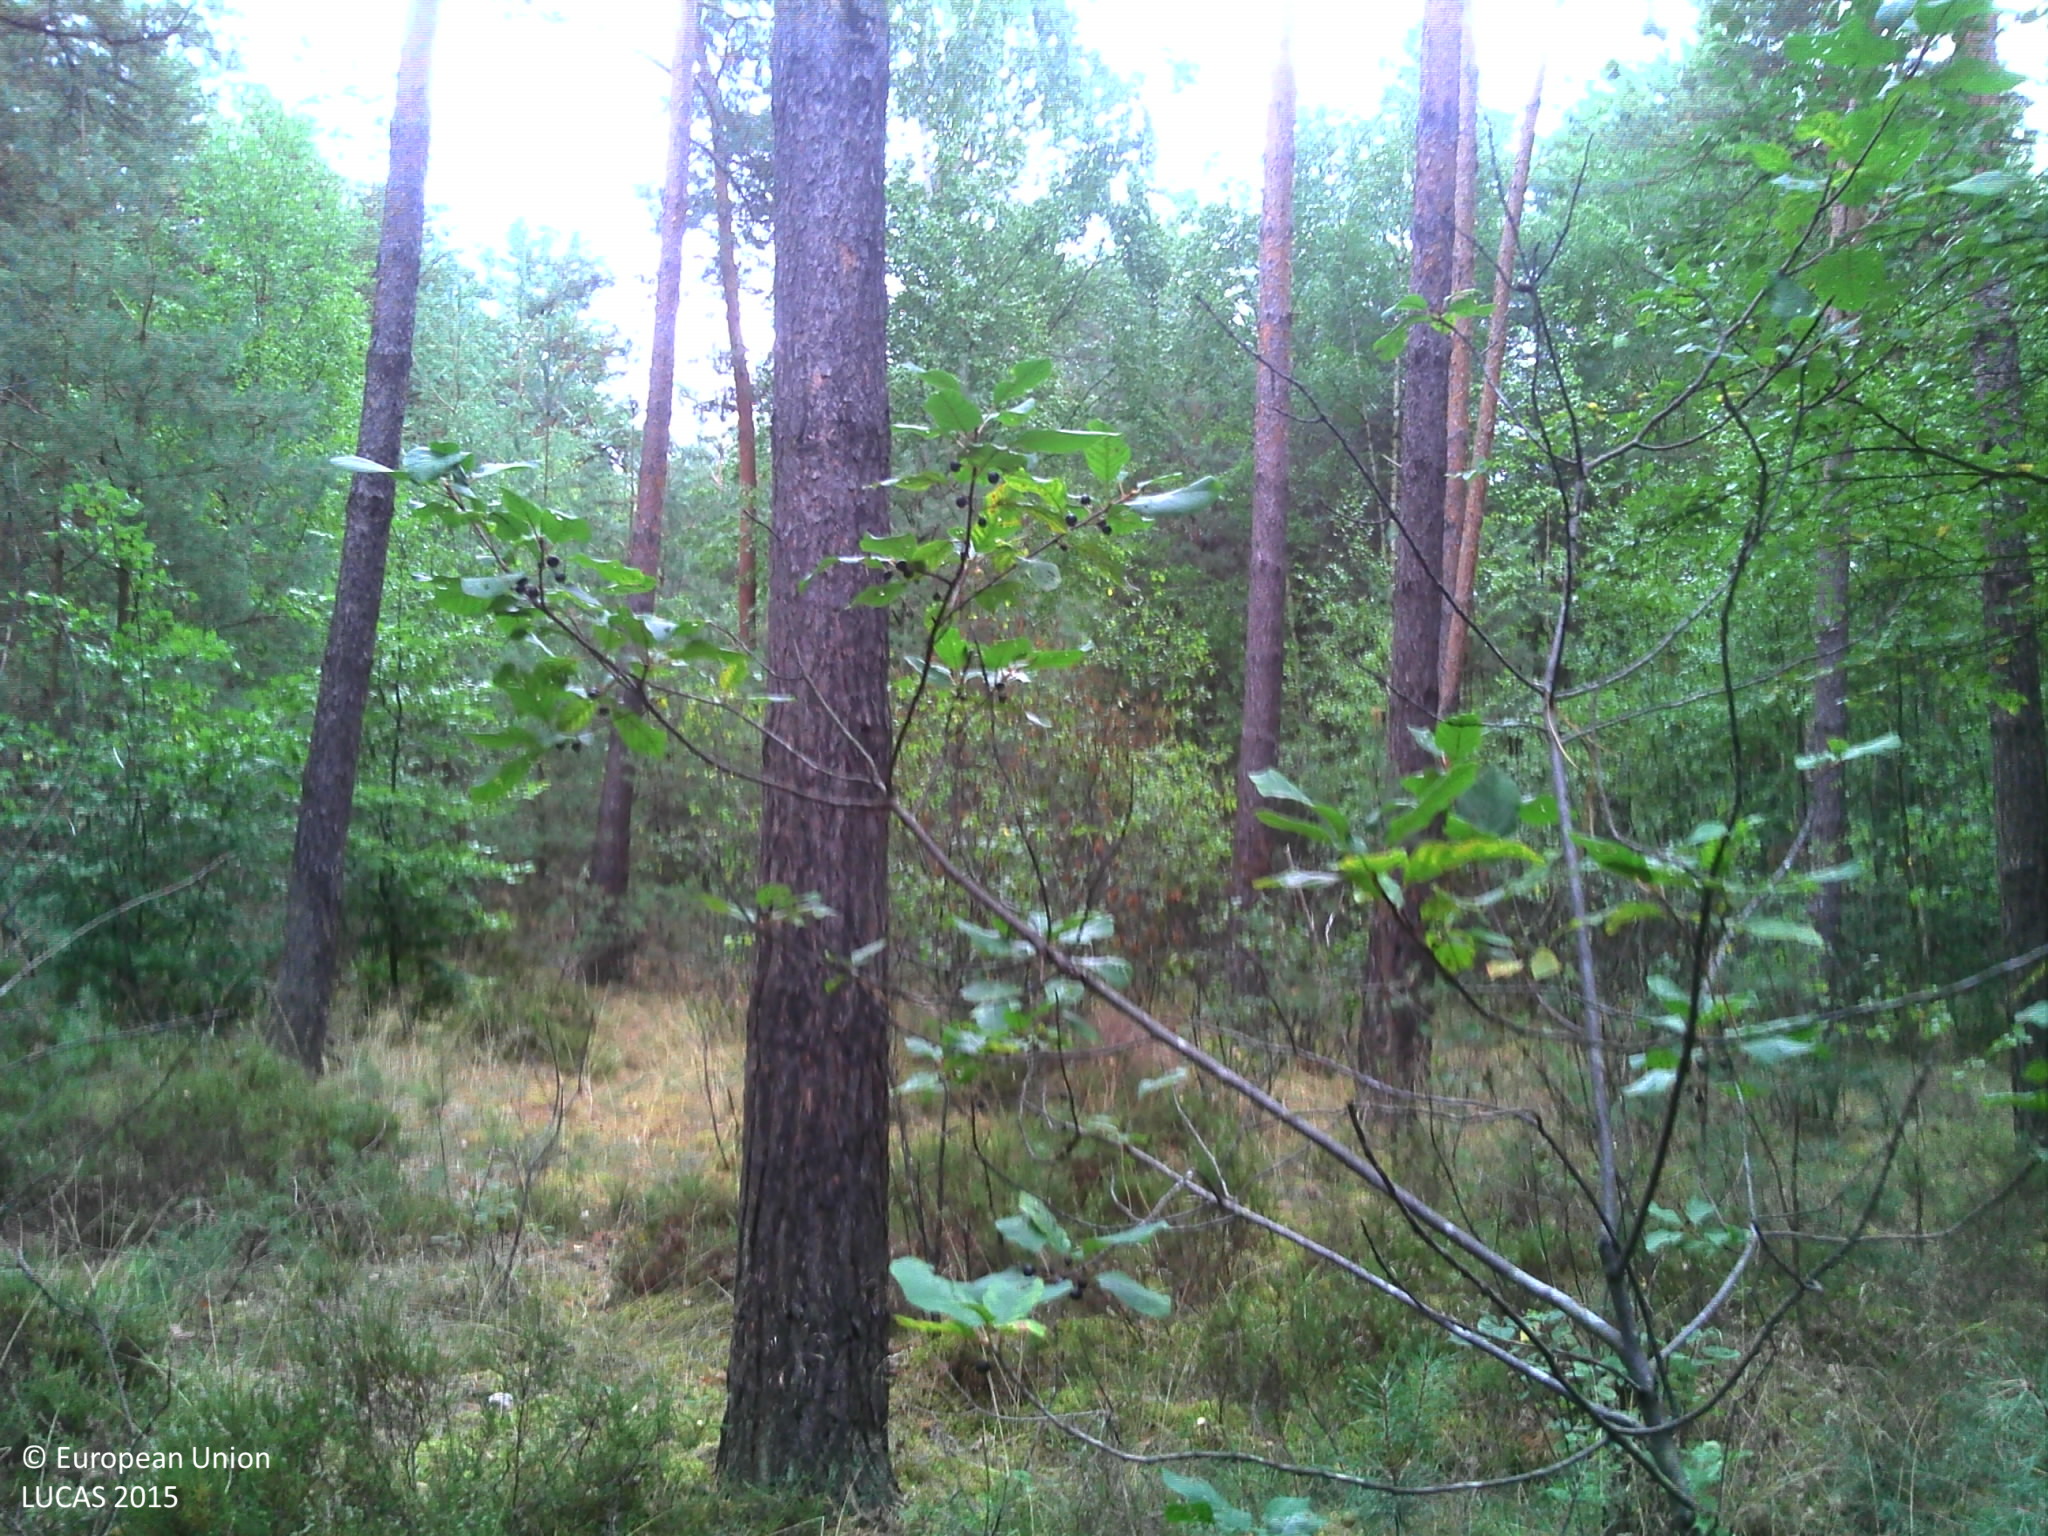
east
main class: Woodland
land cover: Pine dominated coniferous woodland
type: hemiboreal forest and nemoral coniferous forest and mixed broadleaved-coniferous forest
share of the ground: > 75 %
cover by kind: coniferous forest trees 70 %, broadleaved forest trees 15 %, lichens and mosses 10 %, herbaceous plants 5 %
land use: Forestry
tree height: > 5 m
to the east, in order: Pine dominated coniferous woodland; Tracks; Pine dominated coniferous woodland; Tracks; Pine dominated coniferous woodland
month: August
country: FR
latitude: 48.8475
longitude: 7.6977
